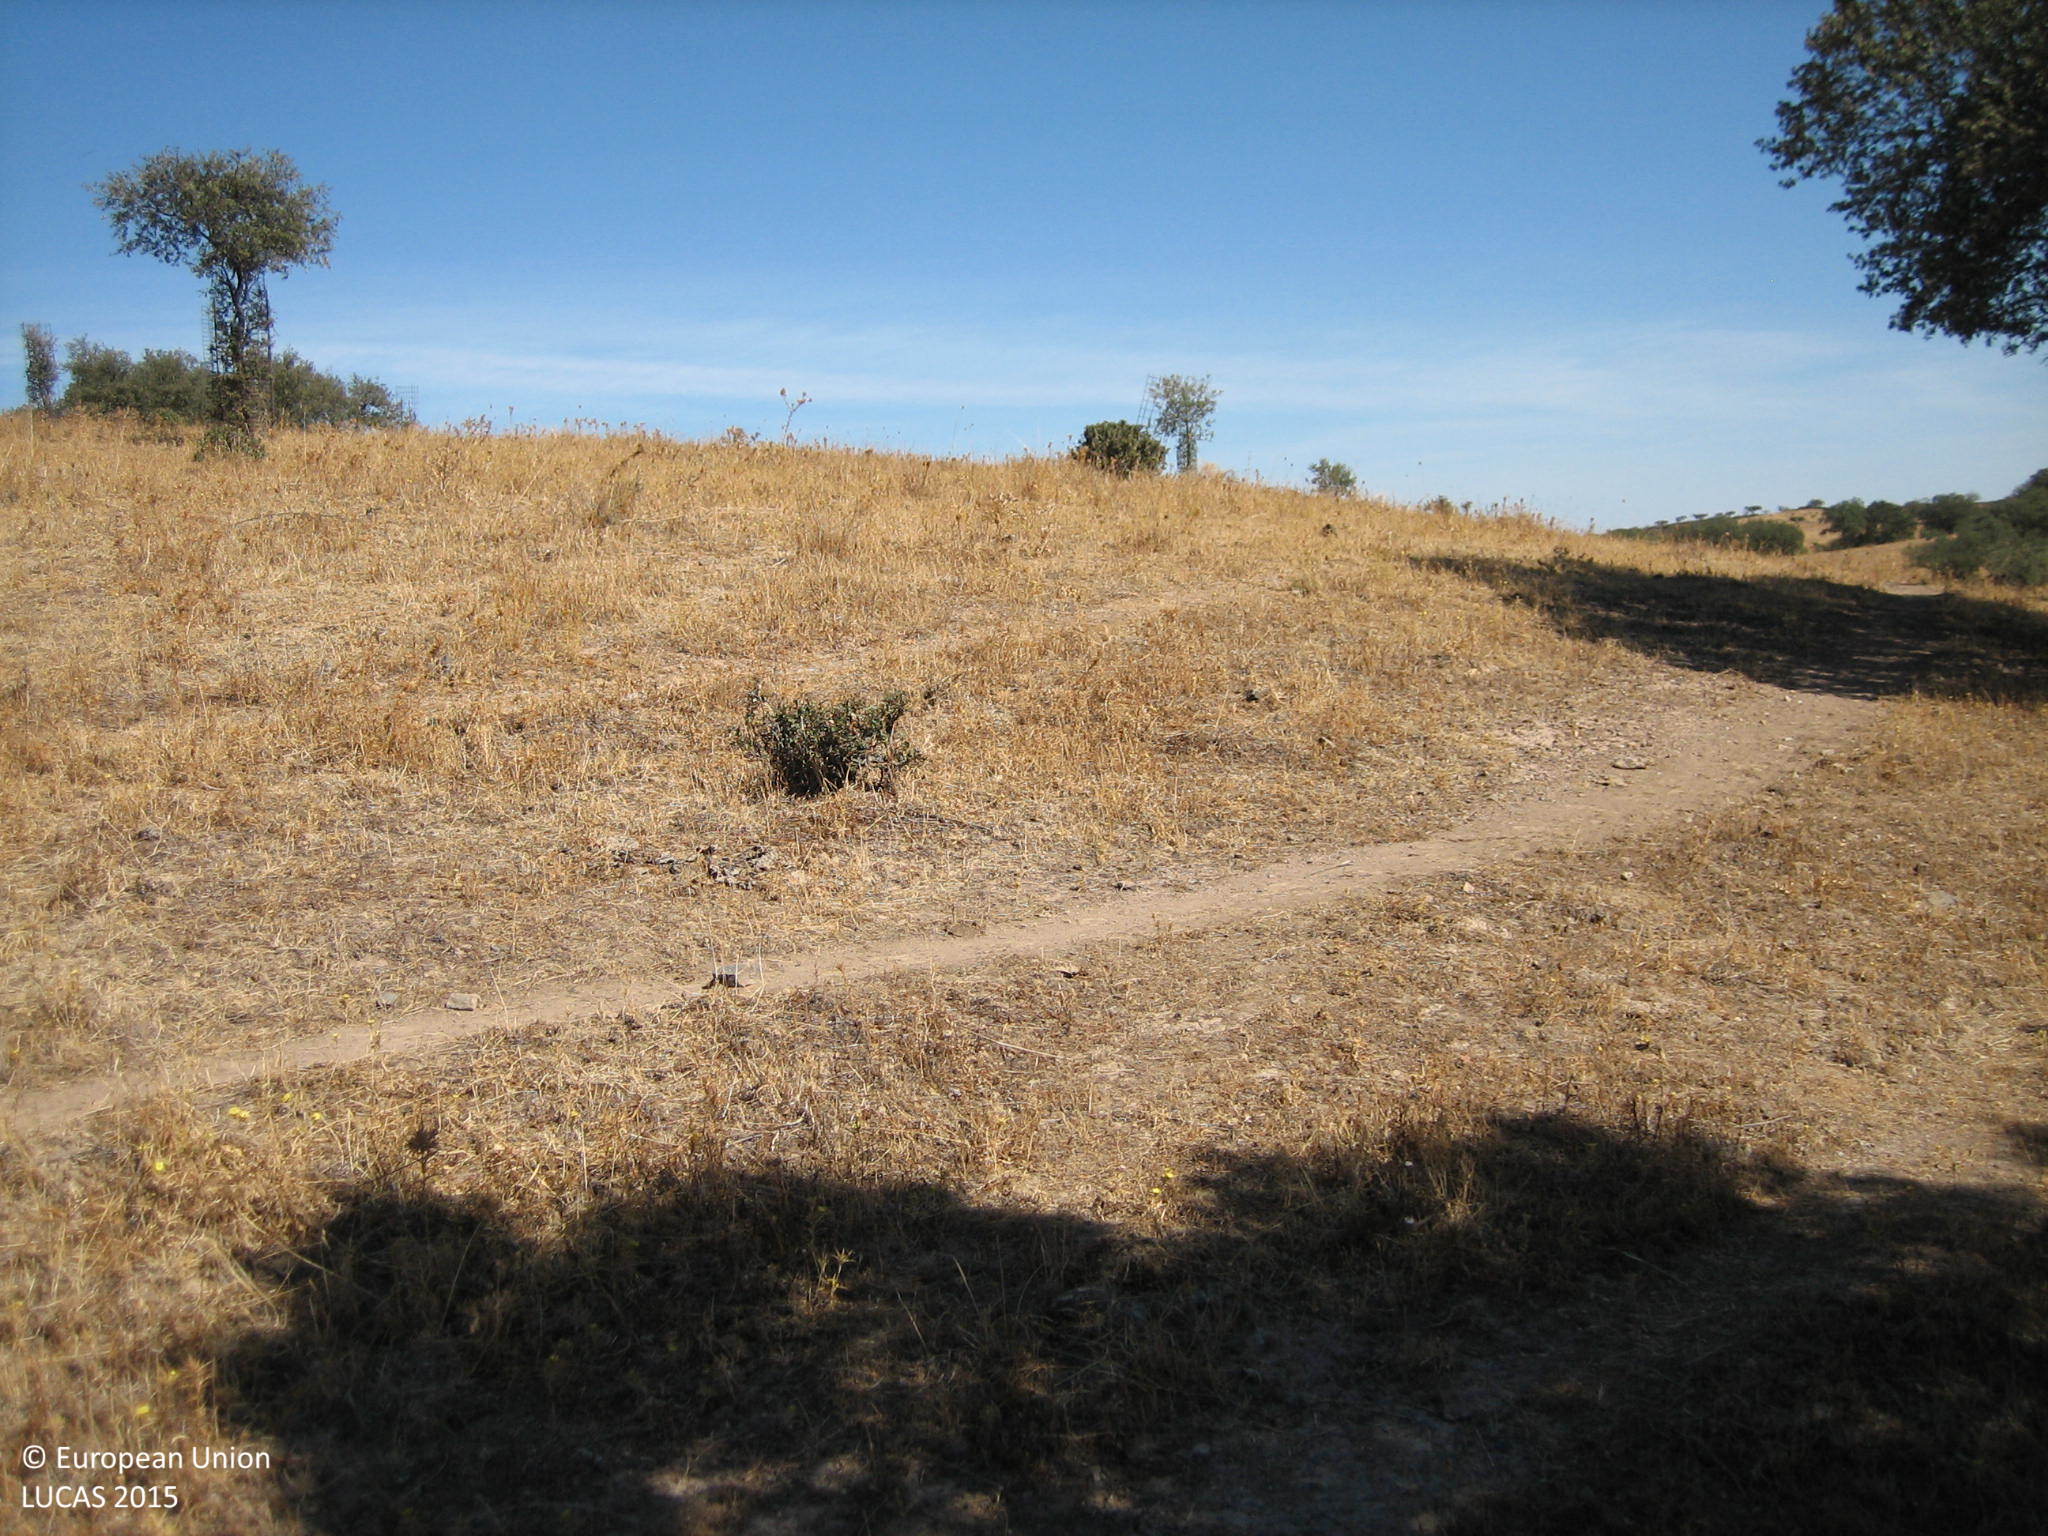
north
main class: Grassland
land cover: Grassland with sparse tree/shrub cover
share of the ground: > 75 %
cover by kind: herbaceous plants 95 %, broadleaved forest trees 5 %
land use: Forestry
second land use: Agriculture (excluding fallow land and kitchen gardens)
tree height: < 5 m
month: August
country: ES
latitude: 38.5332
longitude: -7.1954
